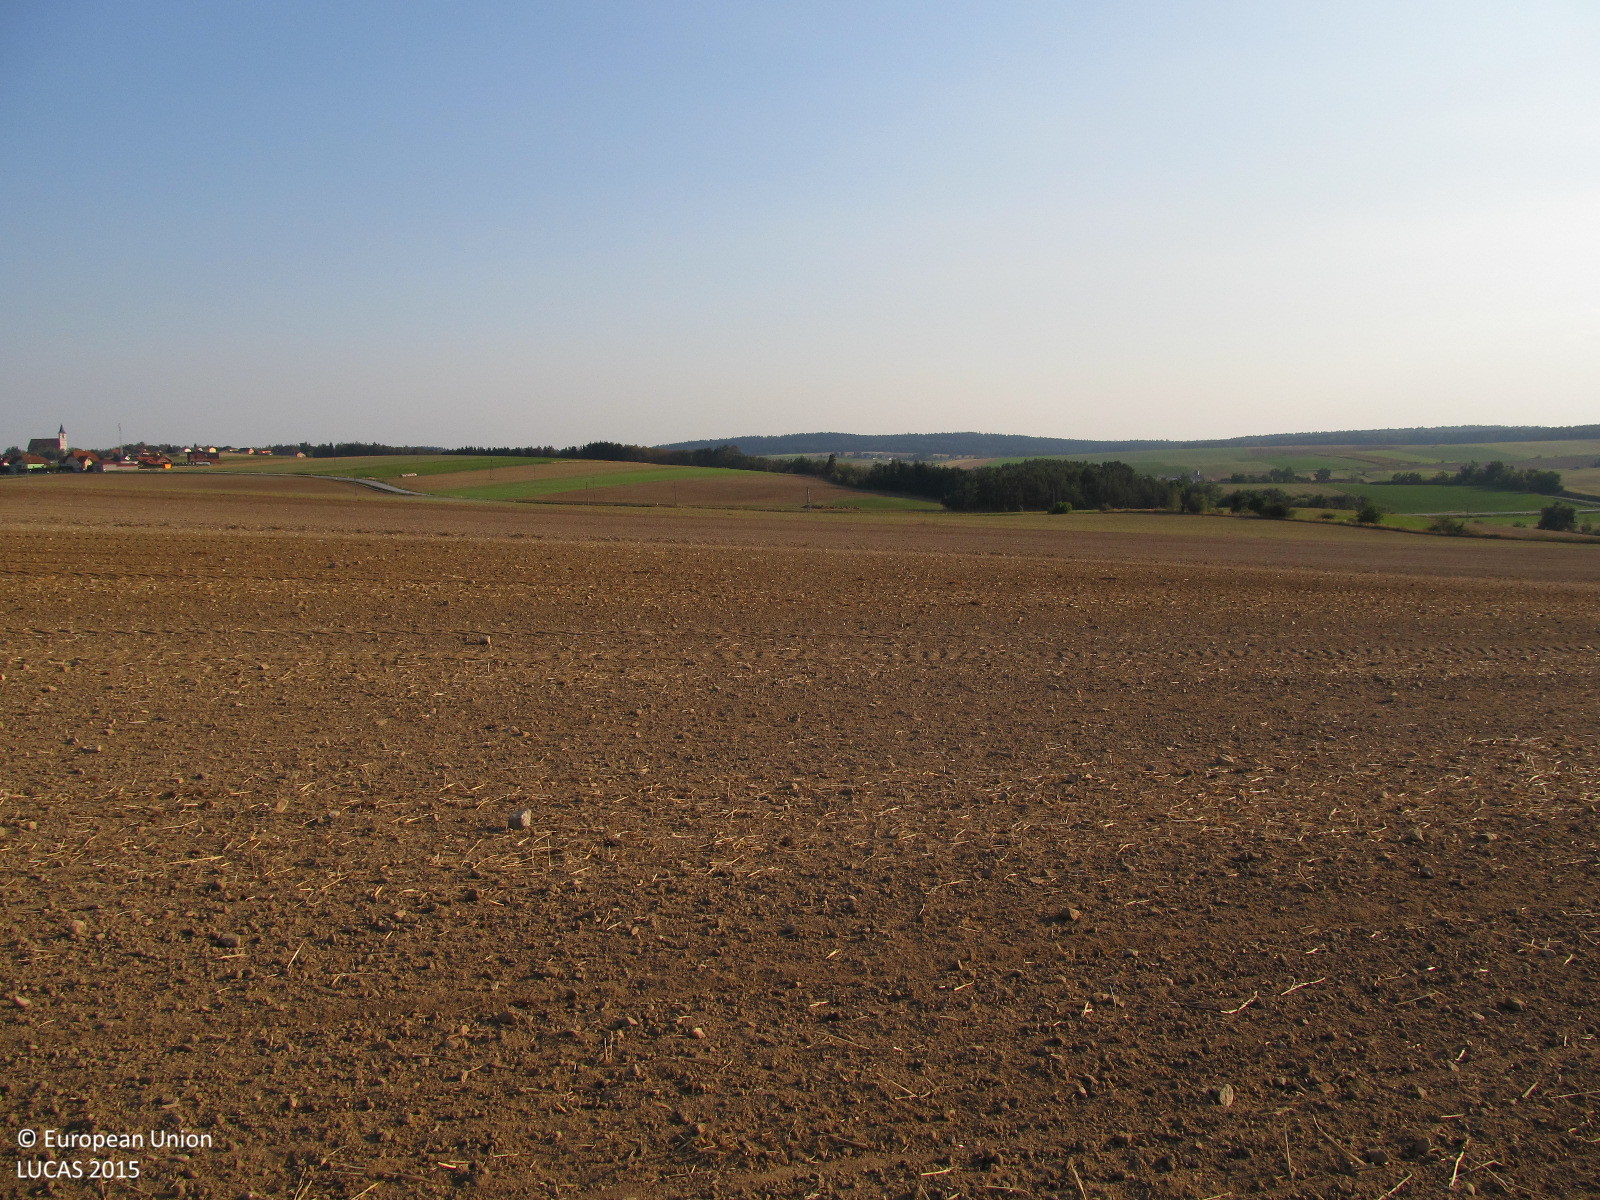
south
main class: Cropland
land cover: Rye
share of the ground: < 10 %
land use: Agriculture (excluding fallow land and kitchen gardens)
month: September
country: AT
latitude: 48.7475
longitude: 15.6203
